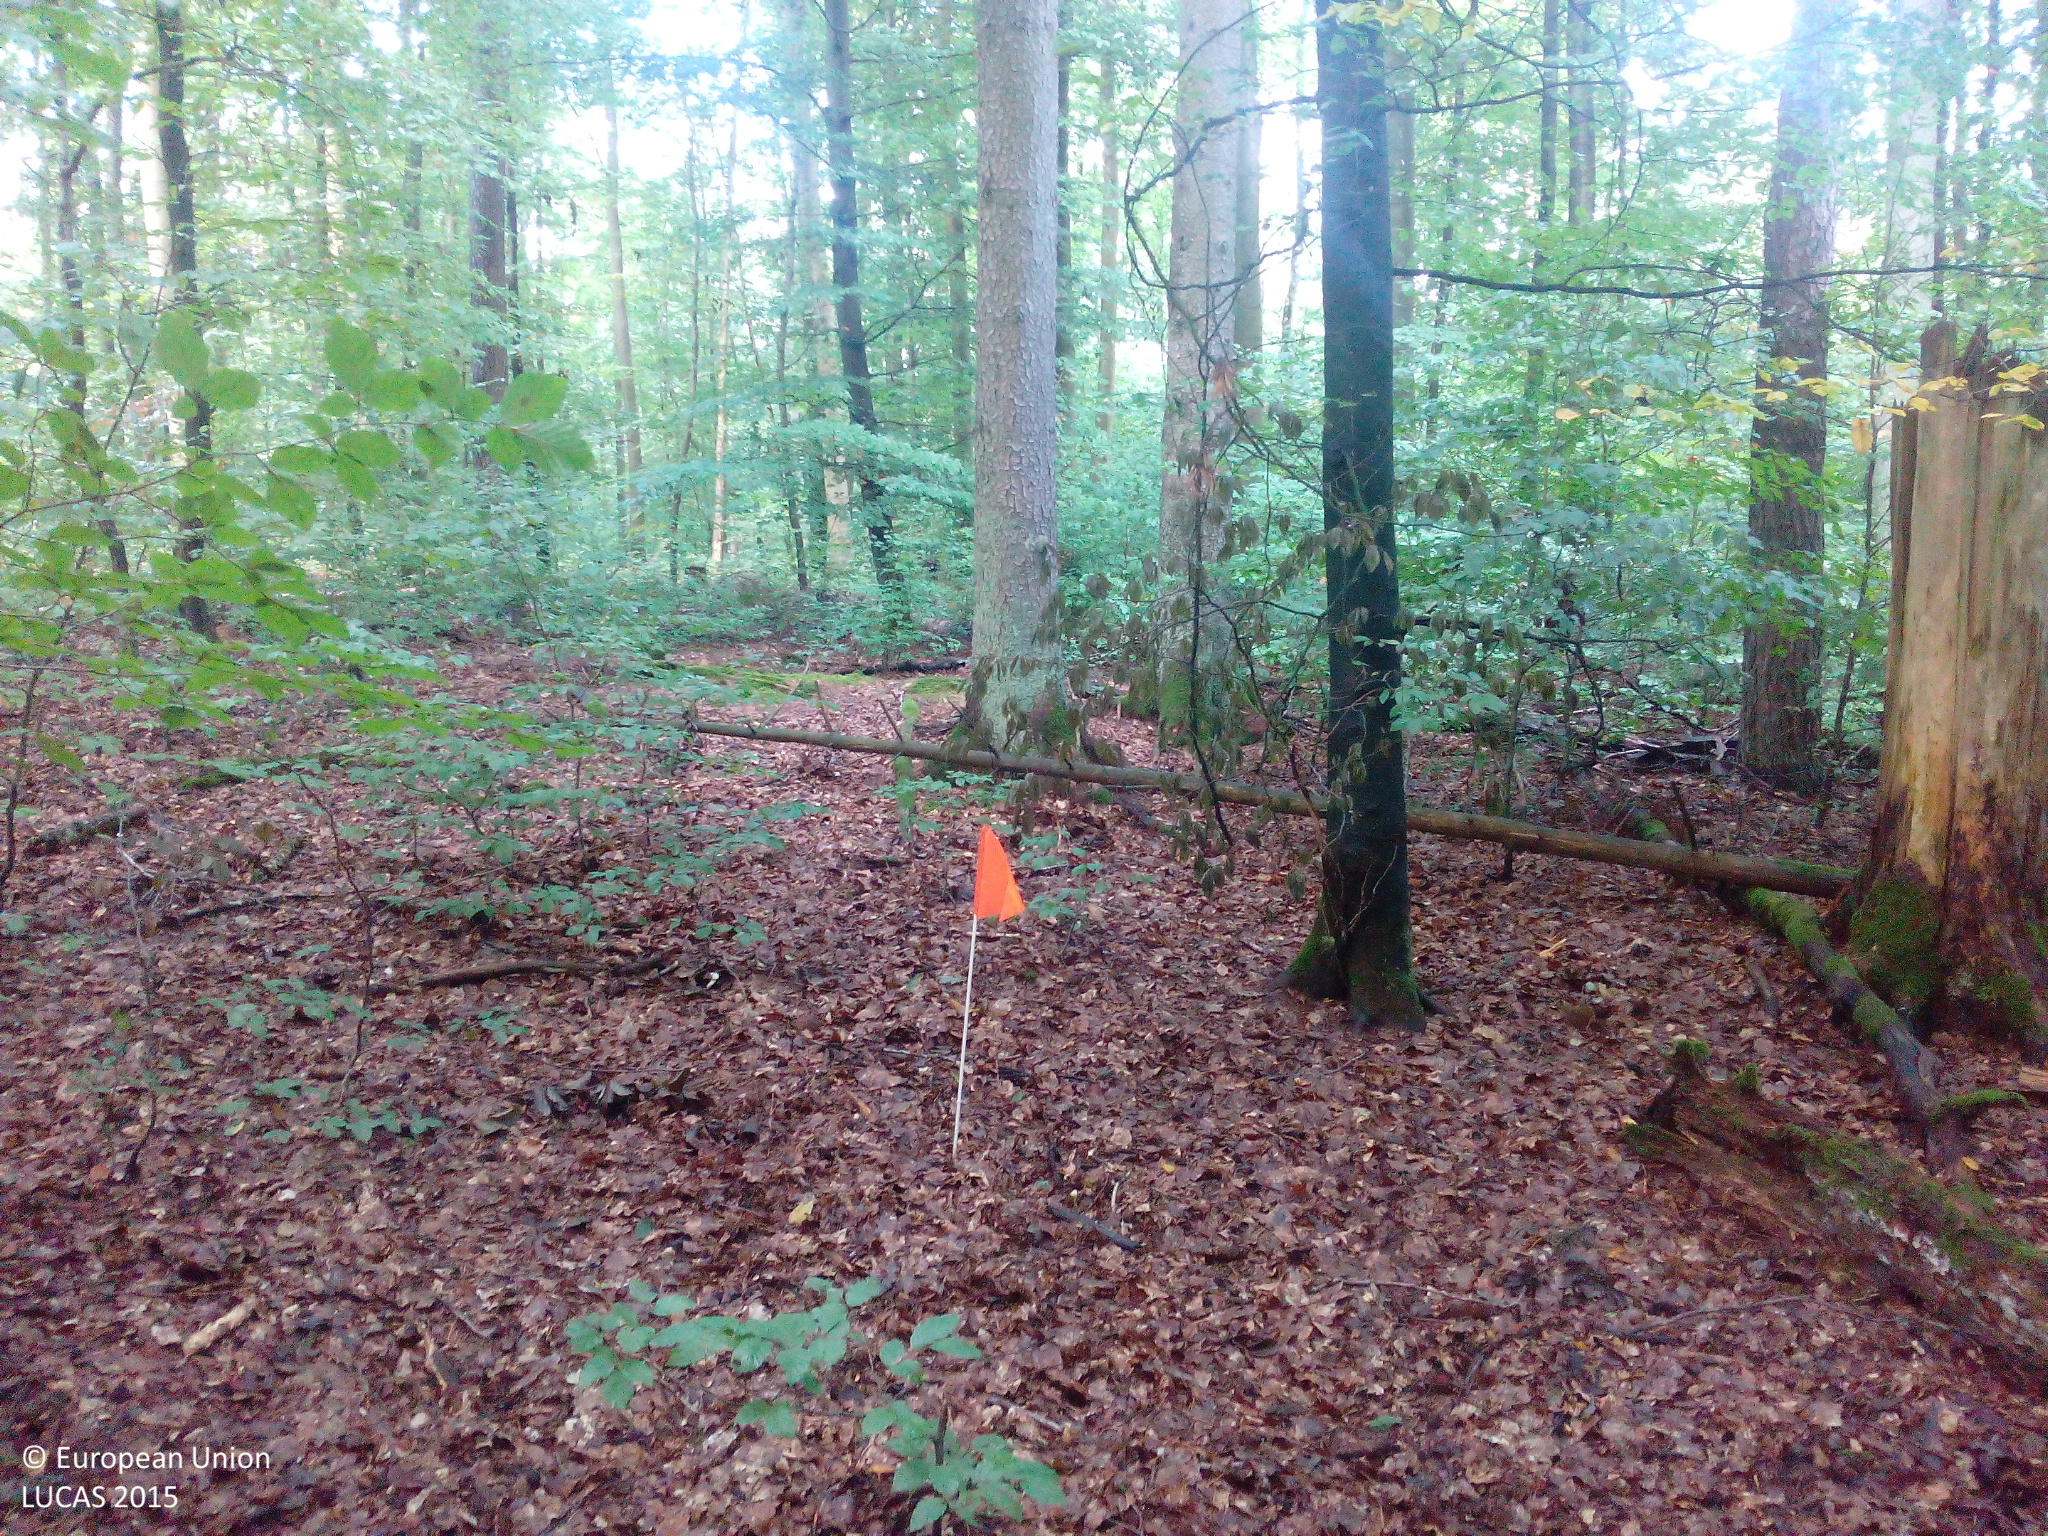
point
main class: Woodland
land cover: Broadleaved woodland
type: beech forest
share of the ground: > 75 %
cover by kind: broadleaved forest trees 85 %, coniferous forest trees 10 %, unconsolidated bare surface 5 %
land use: Forestry
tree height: > 5 m
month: September
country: DE
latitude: 49.8965
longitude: 9.9304
